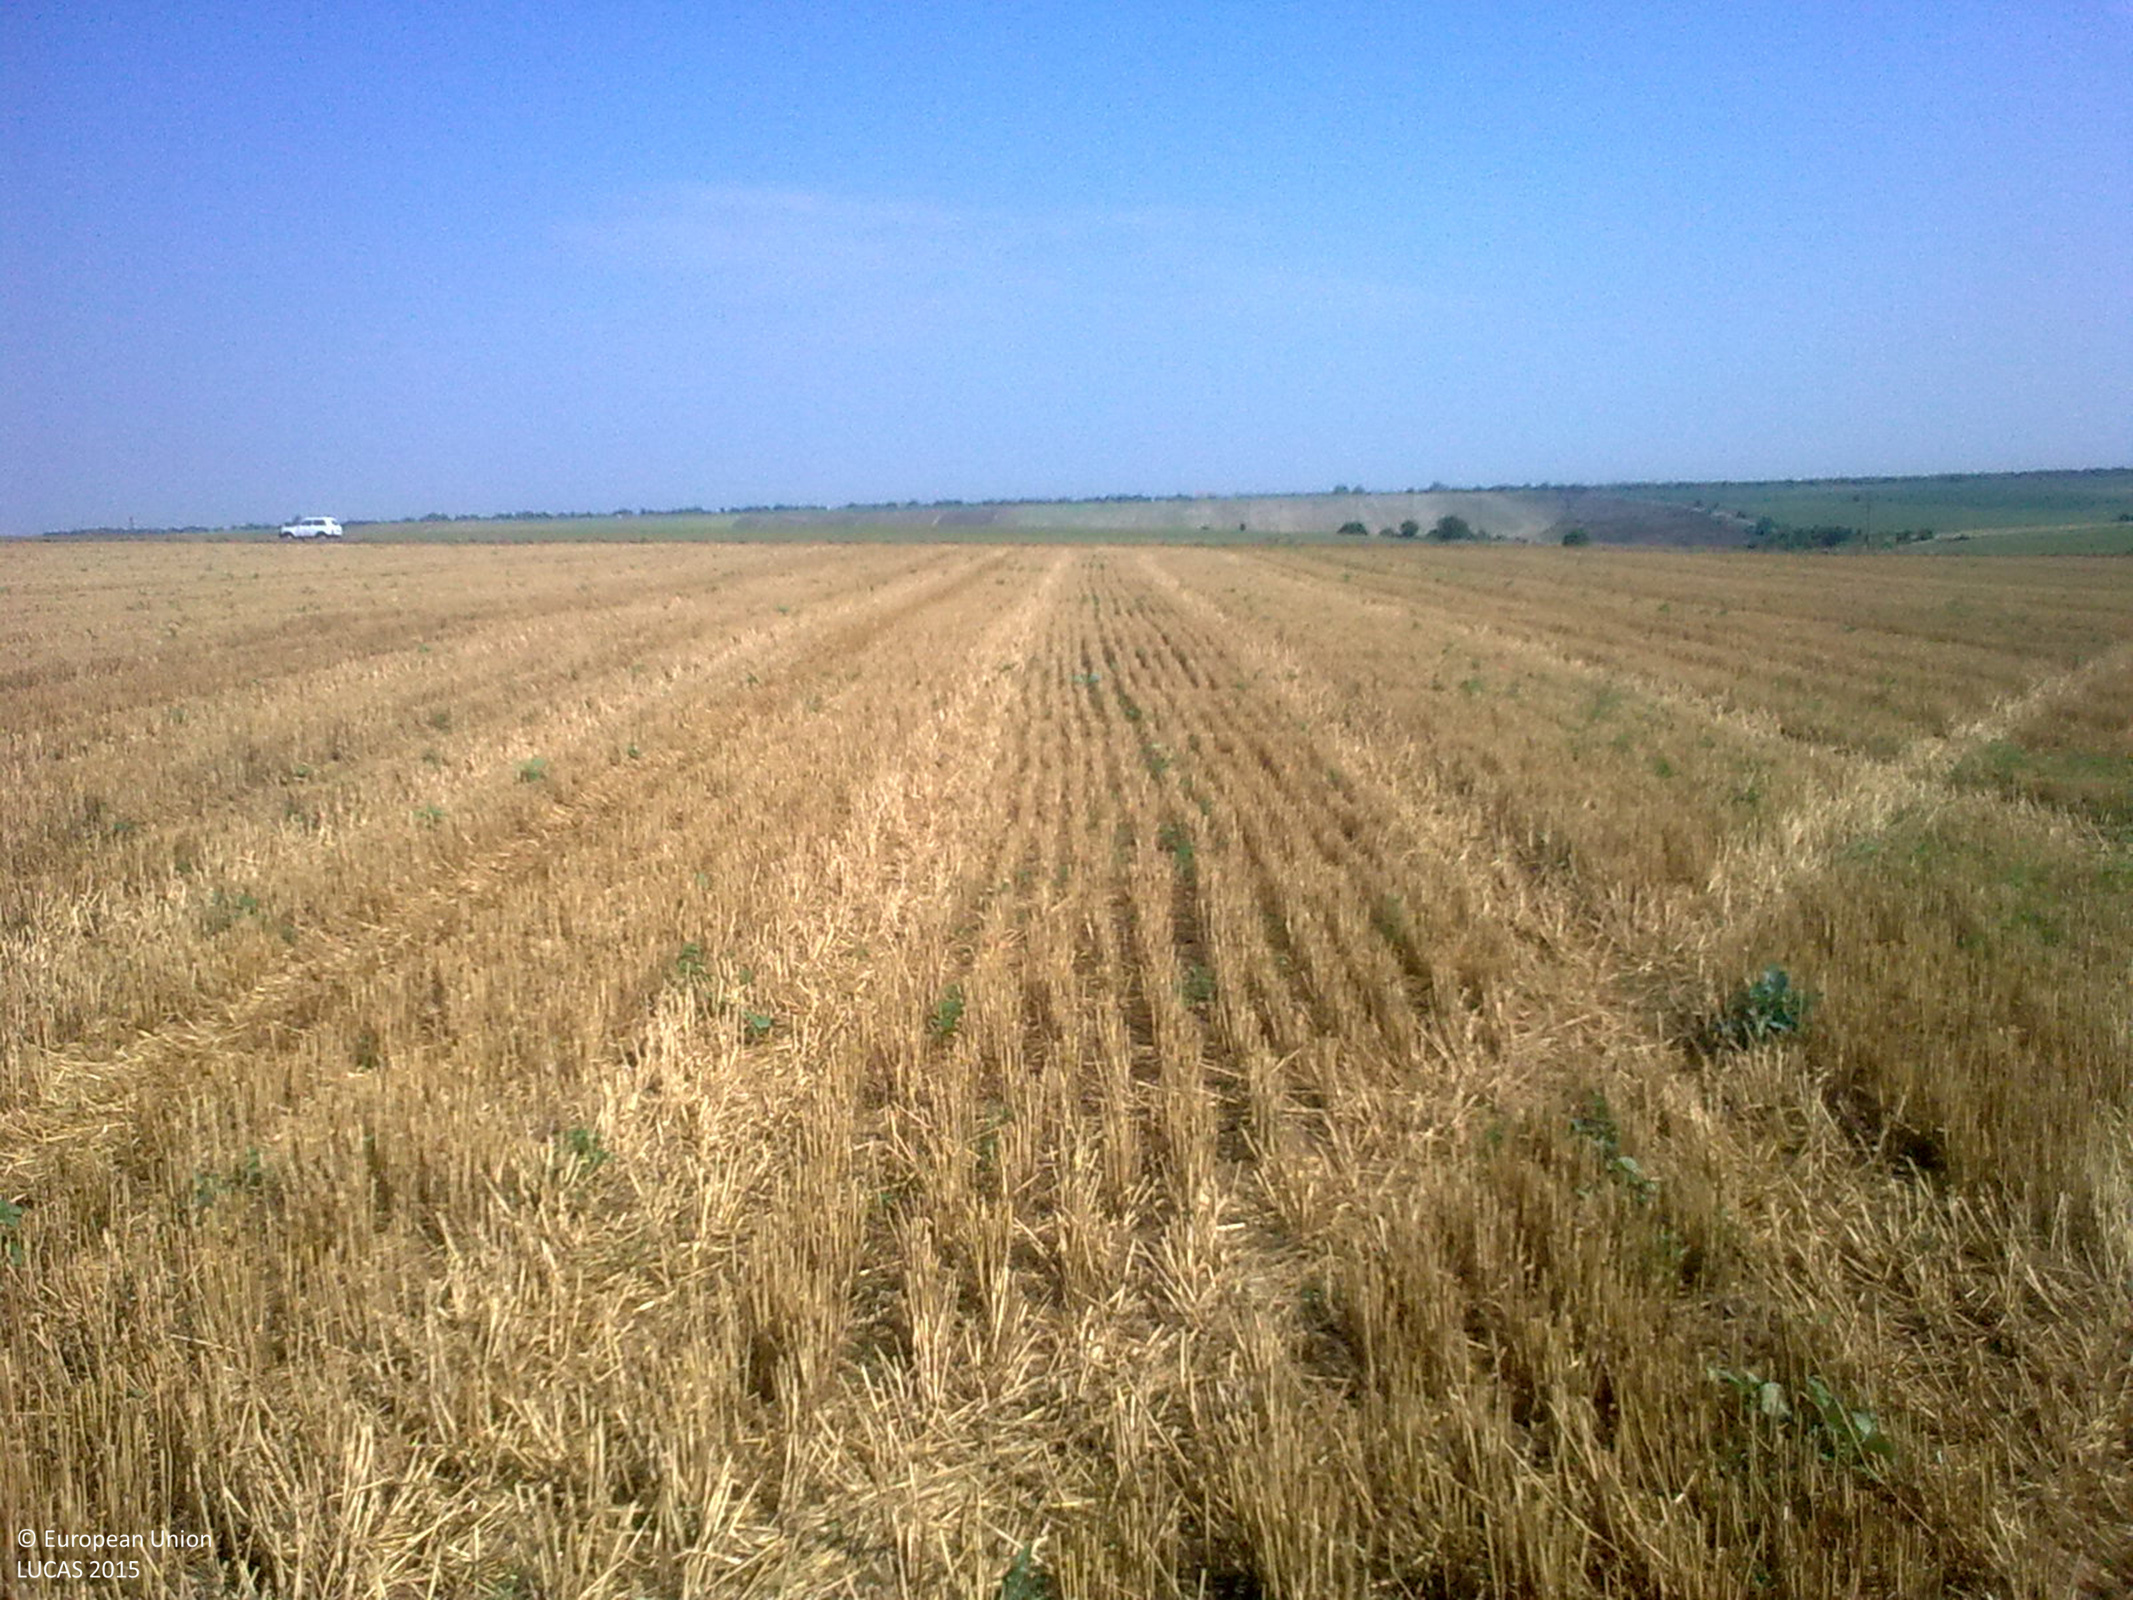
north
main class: Cropland
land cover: Common wheat
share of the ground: 50 - 75 %
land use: Agriculture (excluding fallow land and kitchen gardens)
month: July
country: BG
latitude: 43.7870
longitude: 26.2946
